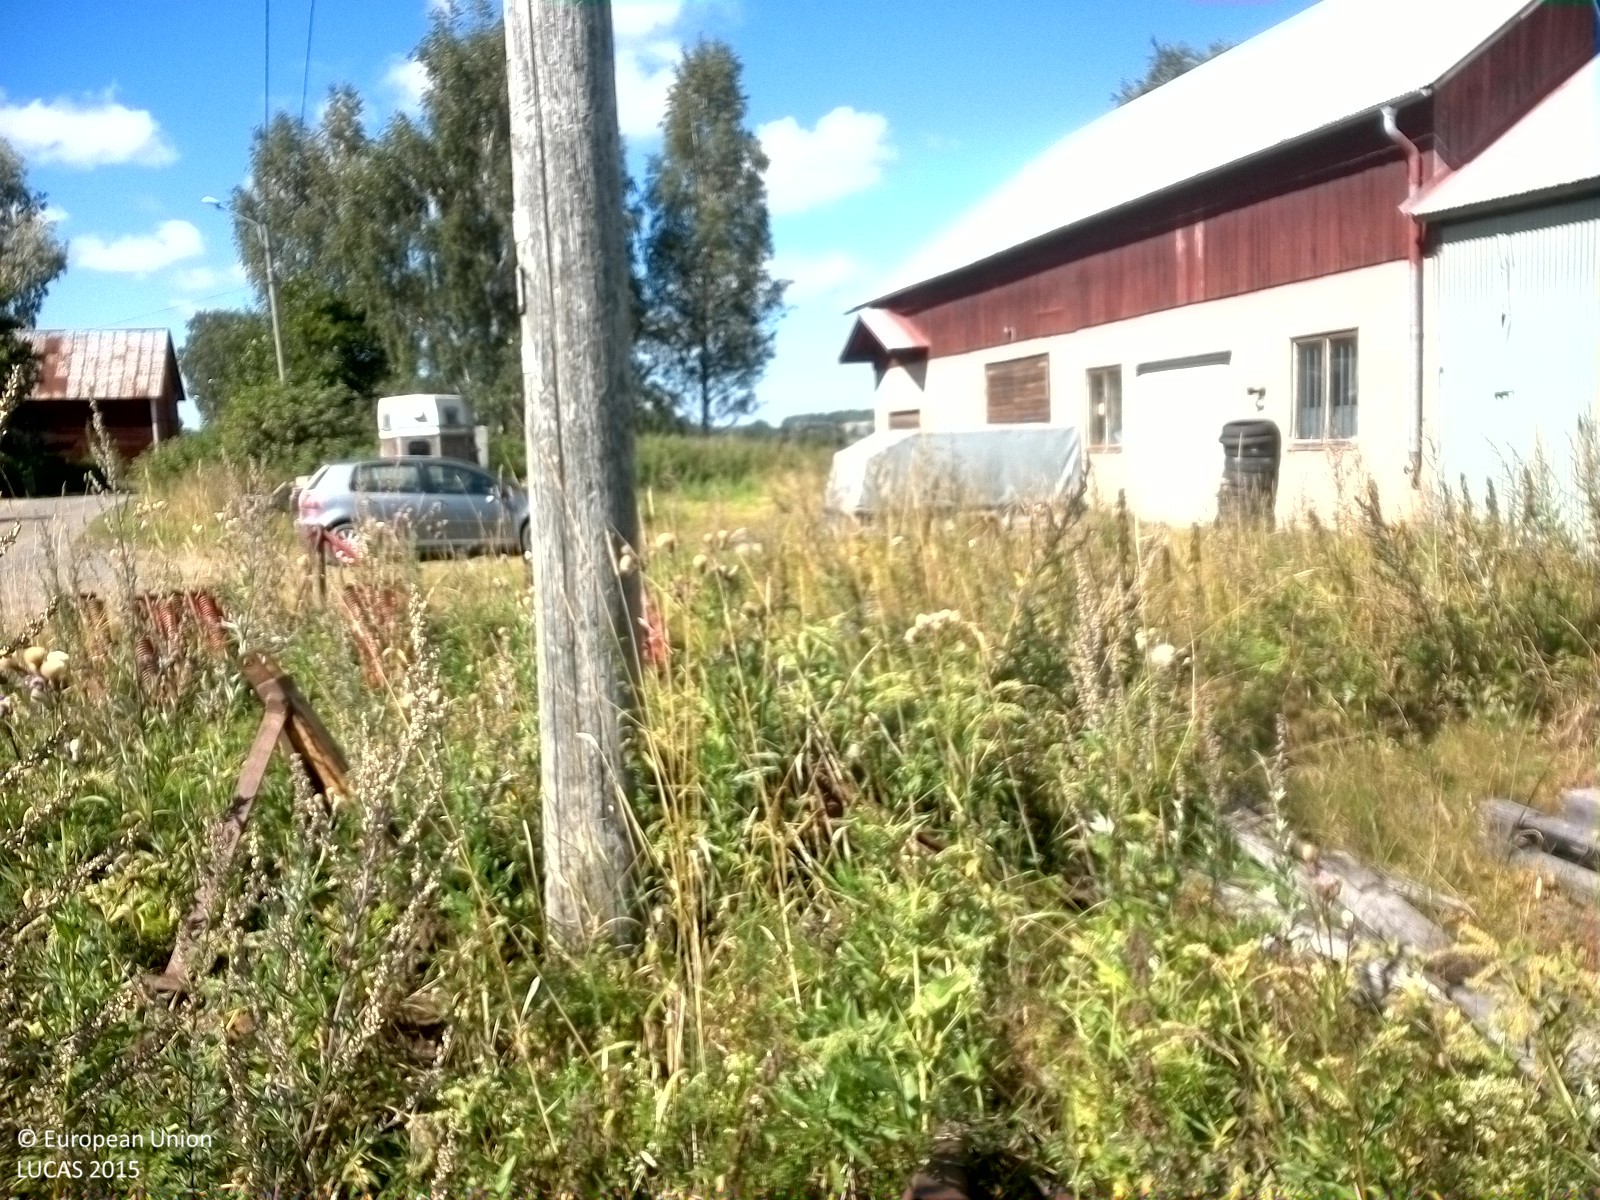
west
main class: Grassland
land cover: Spontaneously vegetated surfaces
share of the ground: > 75 %
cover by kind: herbaceous plants 100 %
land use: Residential
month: August
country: SE
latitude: 59.4702
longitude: 15.2327
